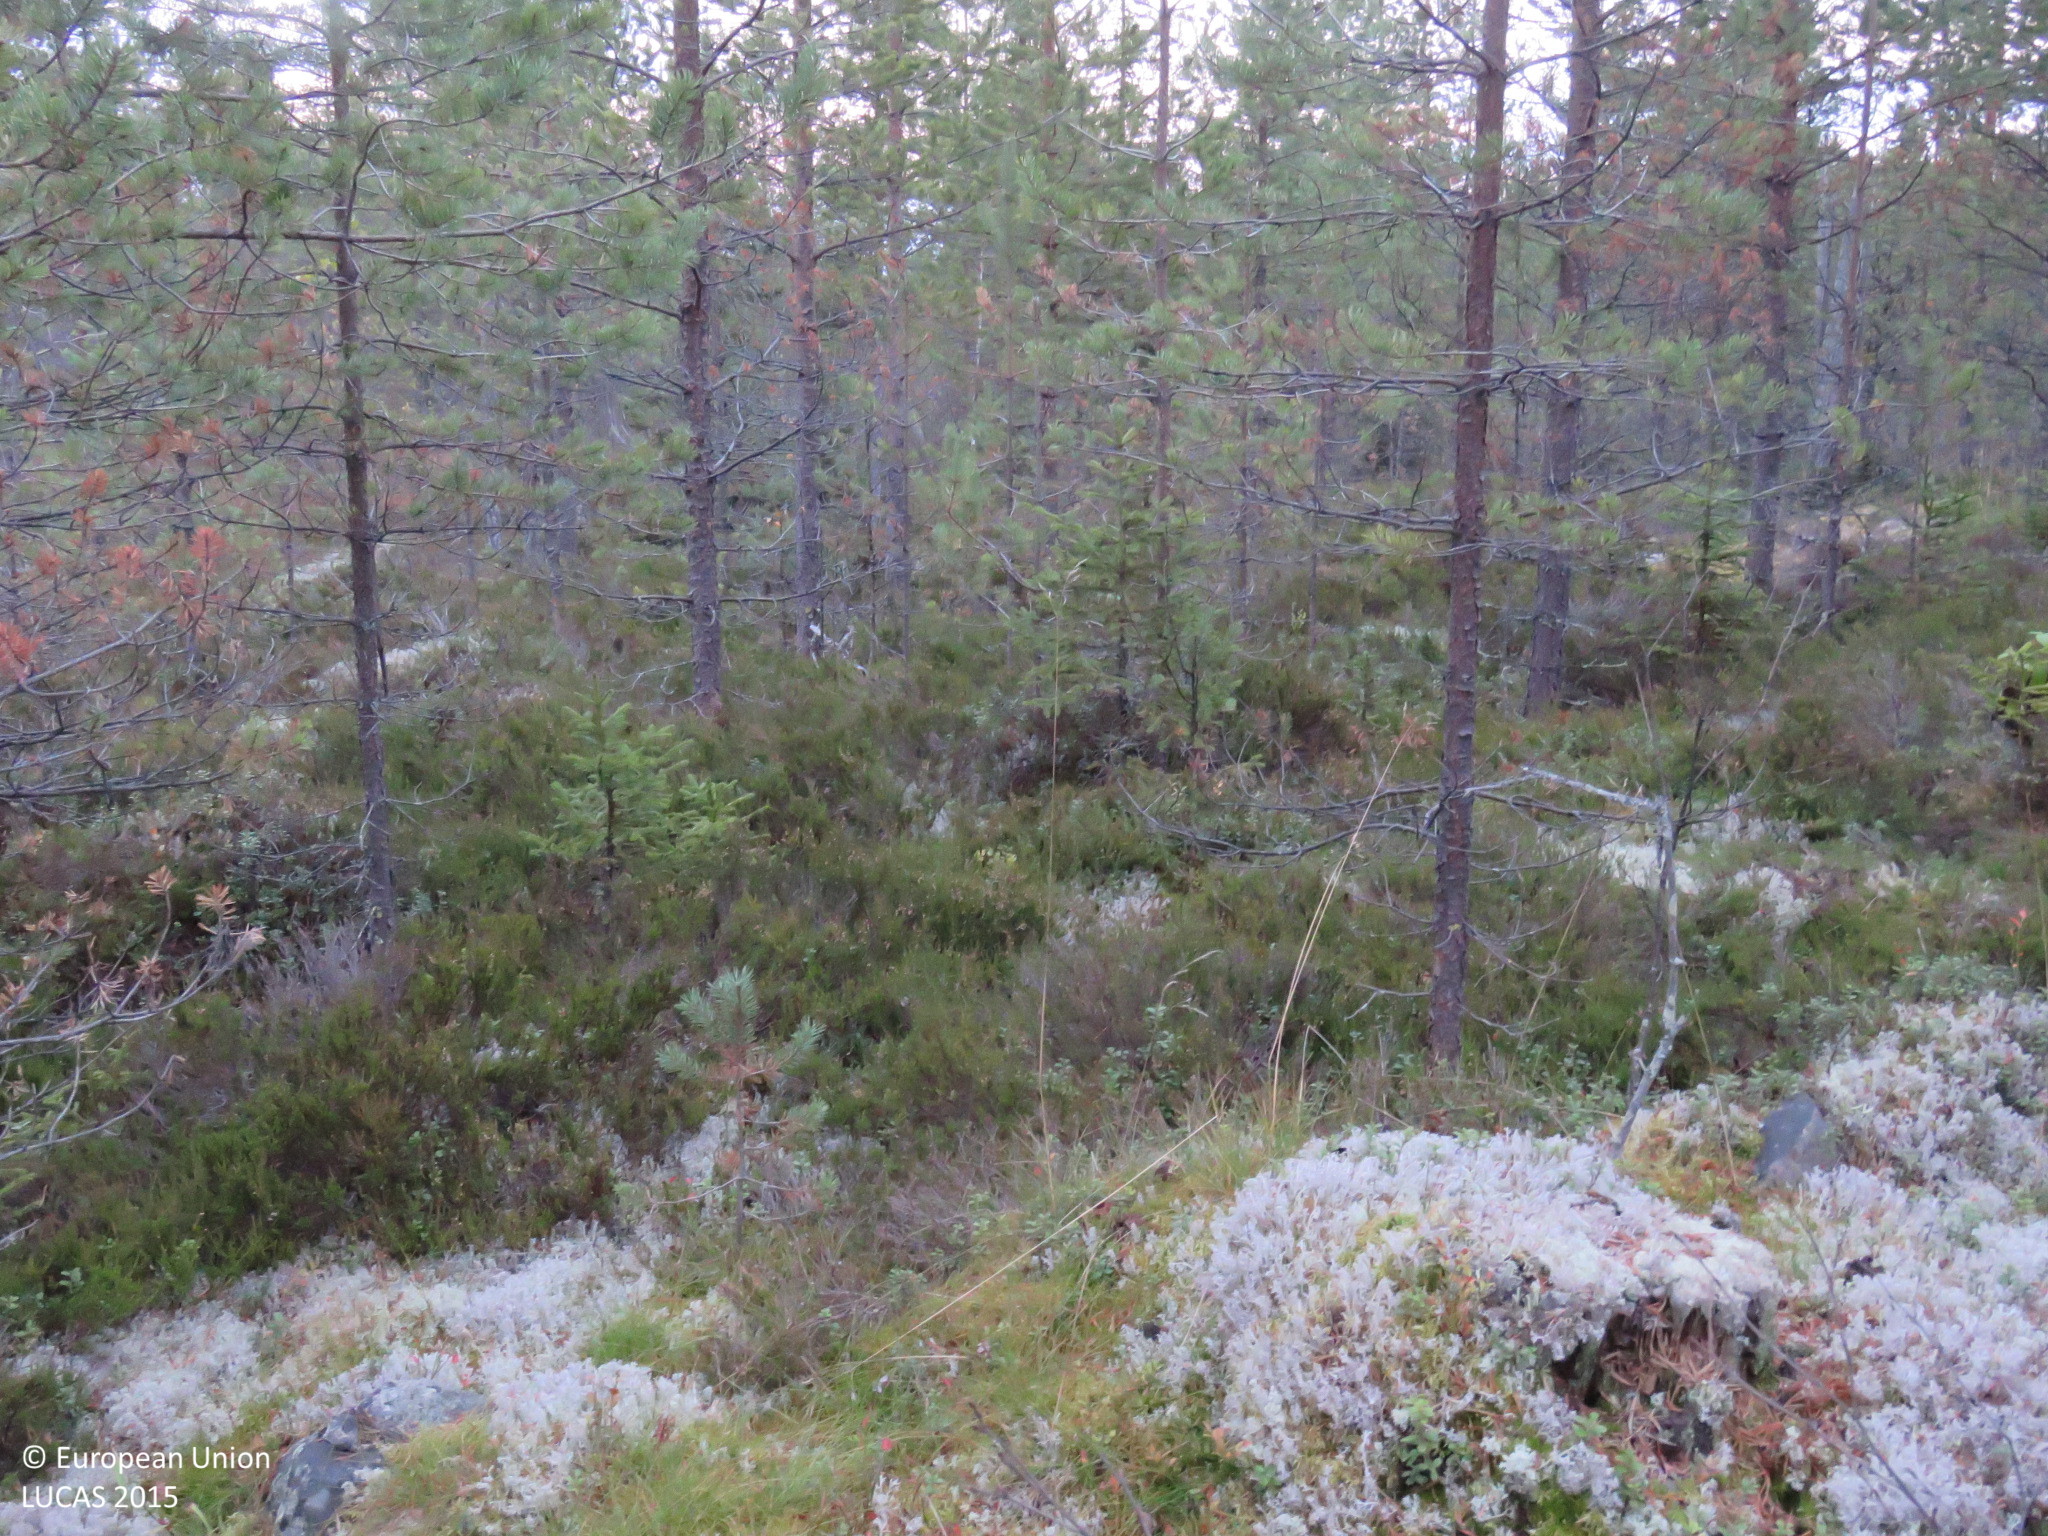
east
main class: Woodland
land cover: Pine dominated coniferous woodland
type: boreal forest
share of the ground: > 75 %
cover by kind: coniferous forest trees 70 %, shrubs 15 %, broadleaved forest trees 5 %, herbaceous plants 5 %, lichens and mosses 5 %
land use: Forestry
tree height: > 5 m
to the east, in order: Pine dominated coniferous woodland; Ditches and canals; Pine dominated coniferous woodland; Ditches and canals; Pine dominated coniferous woodland; Ditches and canals; Pine dominated coniferous woodland; Ditches and canals; Pine dominated coniferous woodland; Peatbogs; Ditches and canals; Pine dominated coniferous woodland; Ditches and canals; Pine dominated coniferous woodland
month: October
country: FI
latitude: 64.7567
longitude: 27.1305
